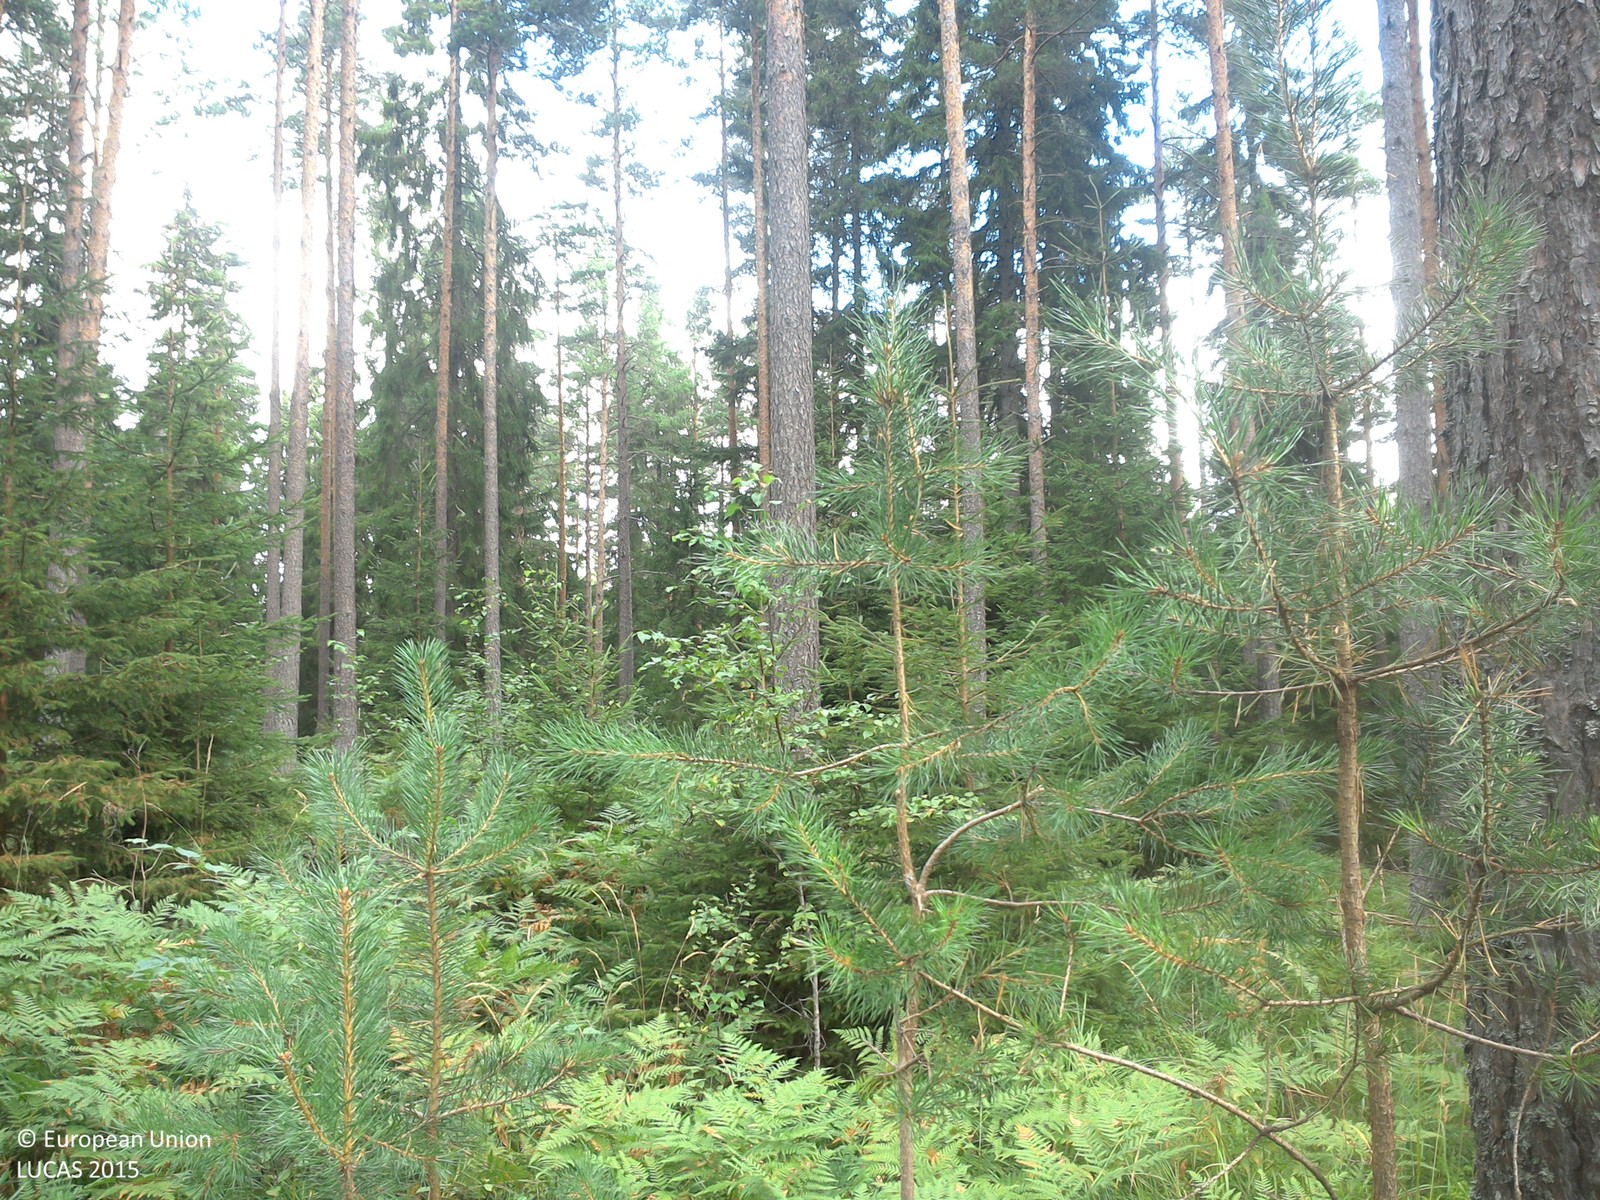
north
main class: Woodland
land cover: Pine dominated coniferous woodland
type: boreal forest
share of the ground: 25 - 50 %
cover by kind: herbaceous plants 50 %, coniferous forest trees 40 %, lichens and mosses 10 %
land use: Forestry
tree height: > 5 m
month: August
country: SE
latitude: 58.0183
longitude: 15.4632
